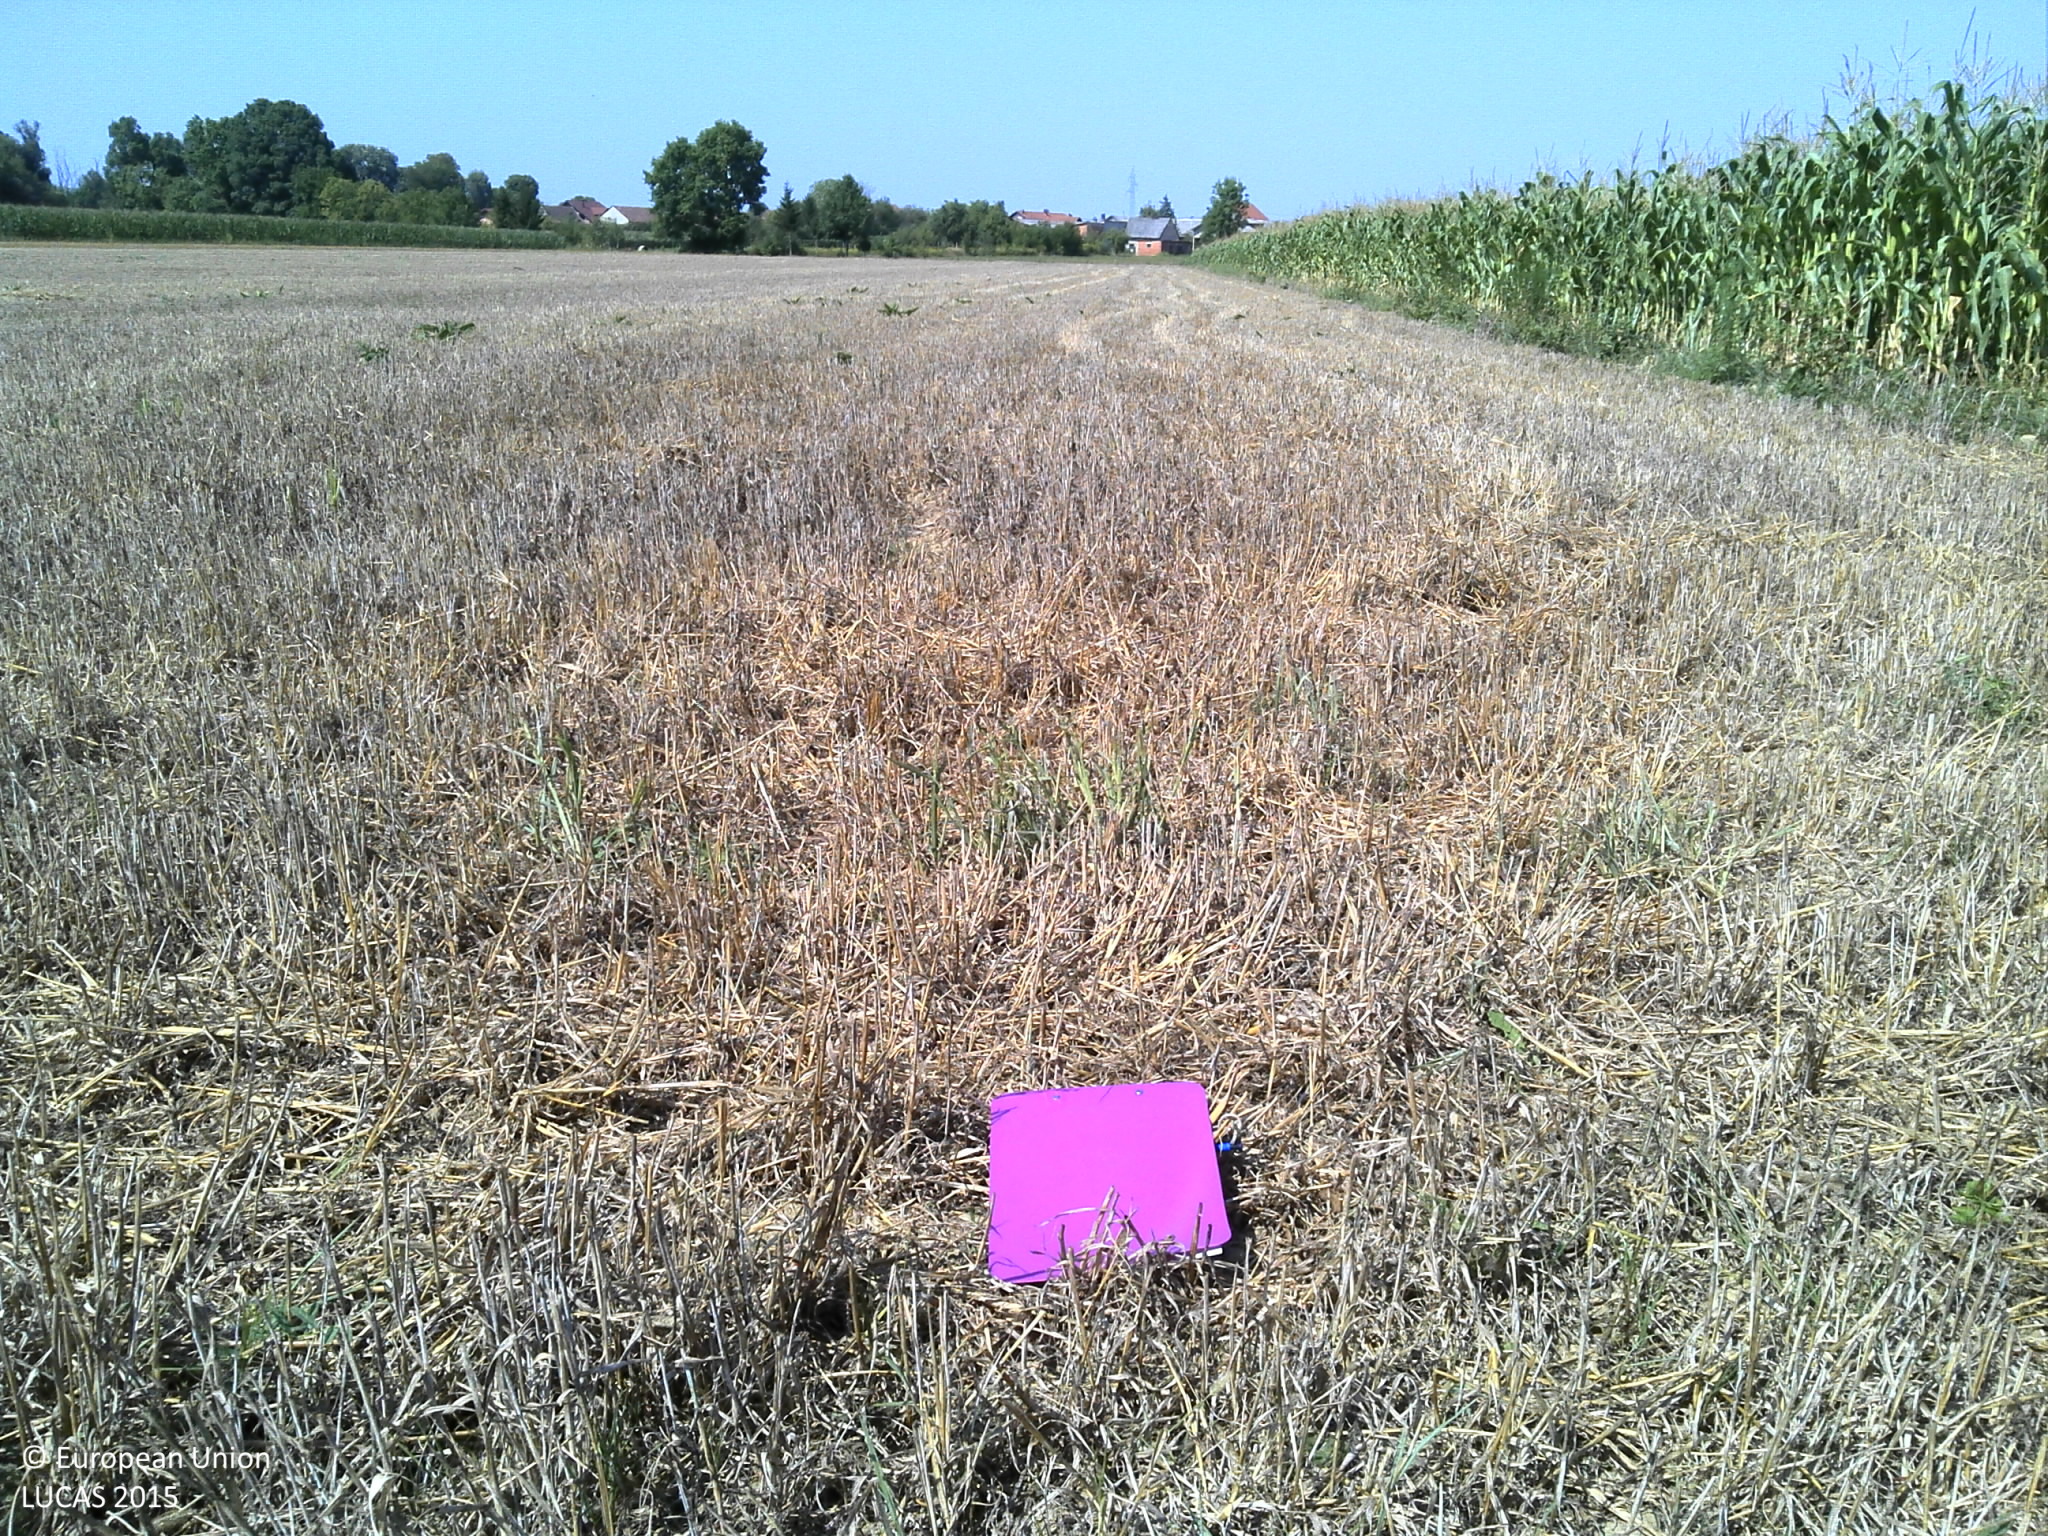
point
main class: Cropland
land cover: Barley
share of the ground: > 75 %
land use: Agriculture (excluding fallow land and kitchen gardens)
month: August
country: HR
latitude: 45.5160
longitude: 16.2831
